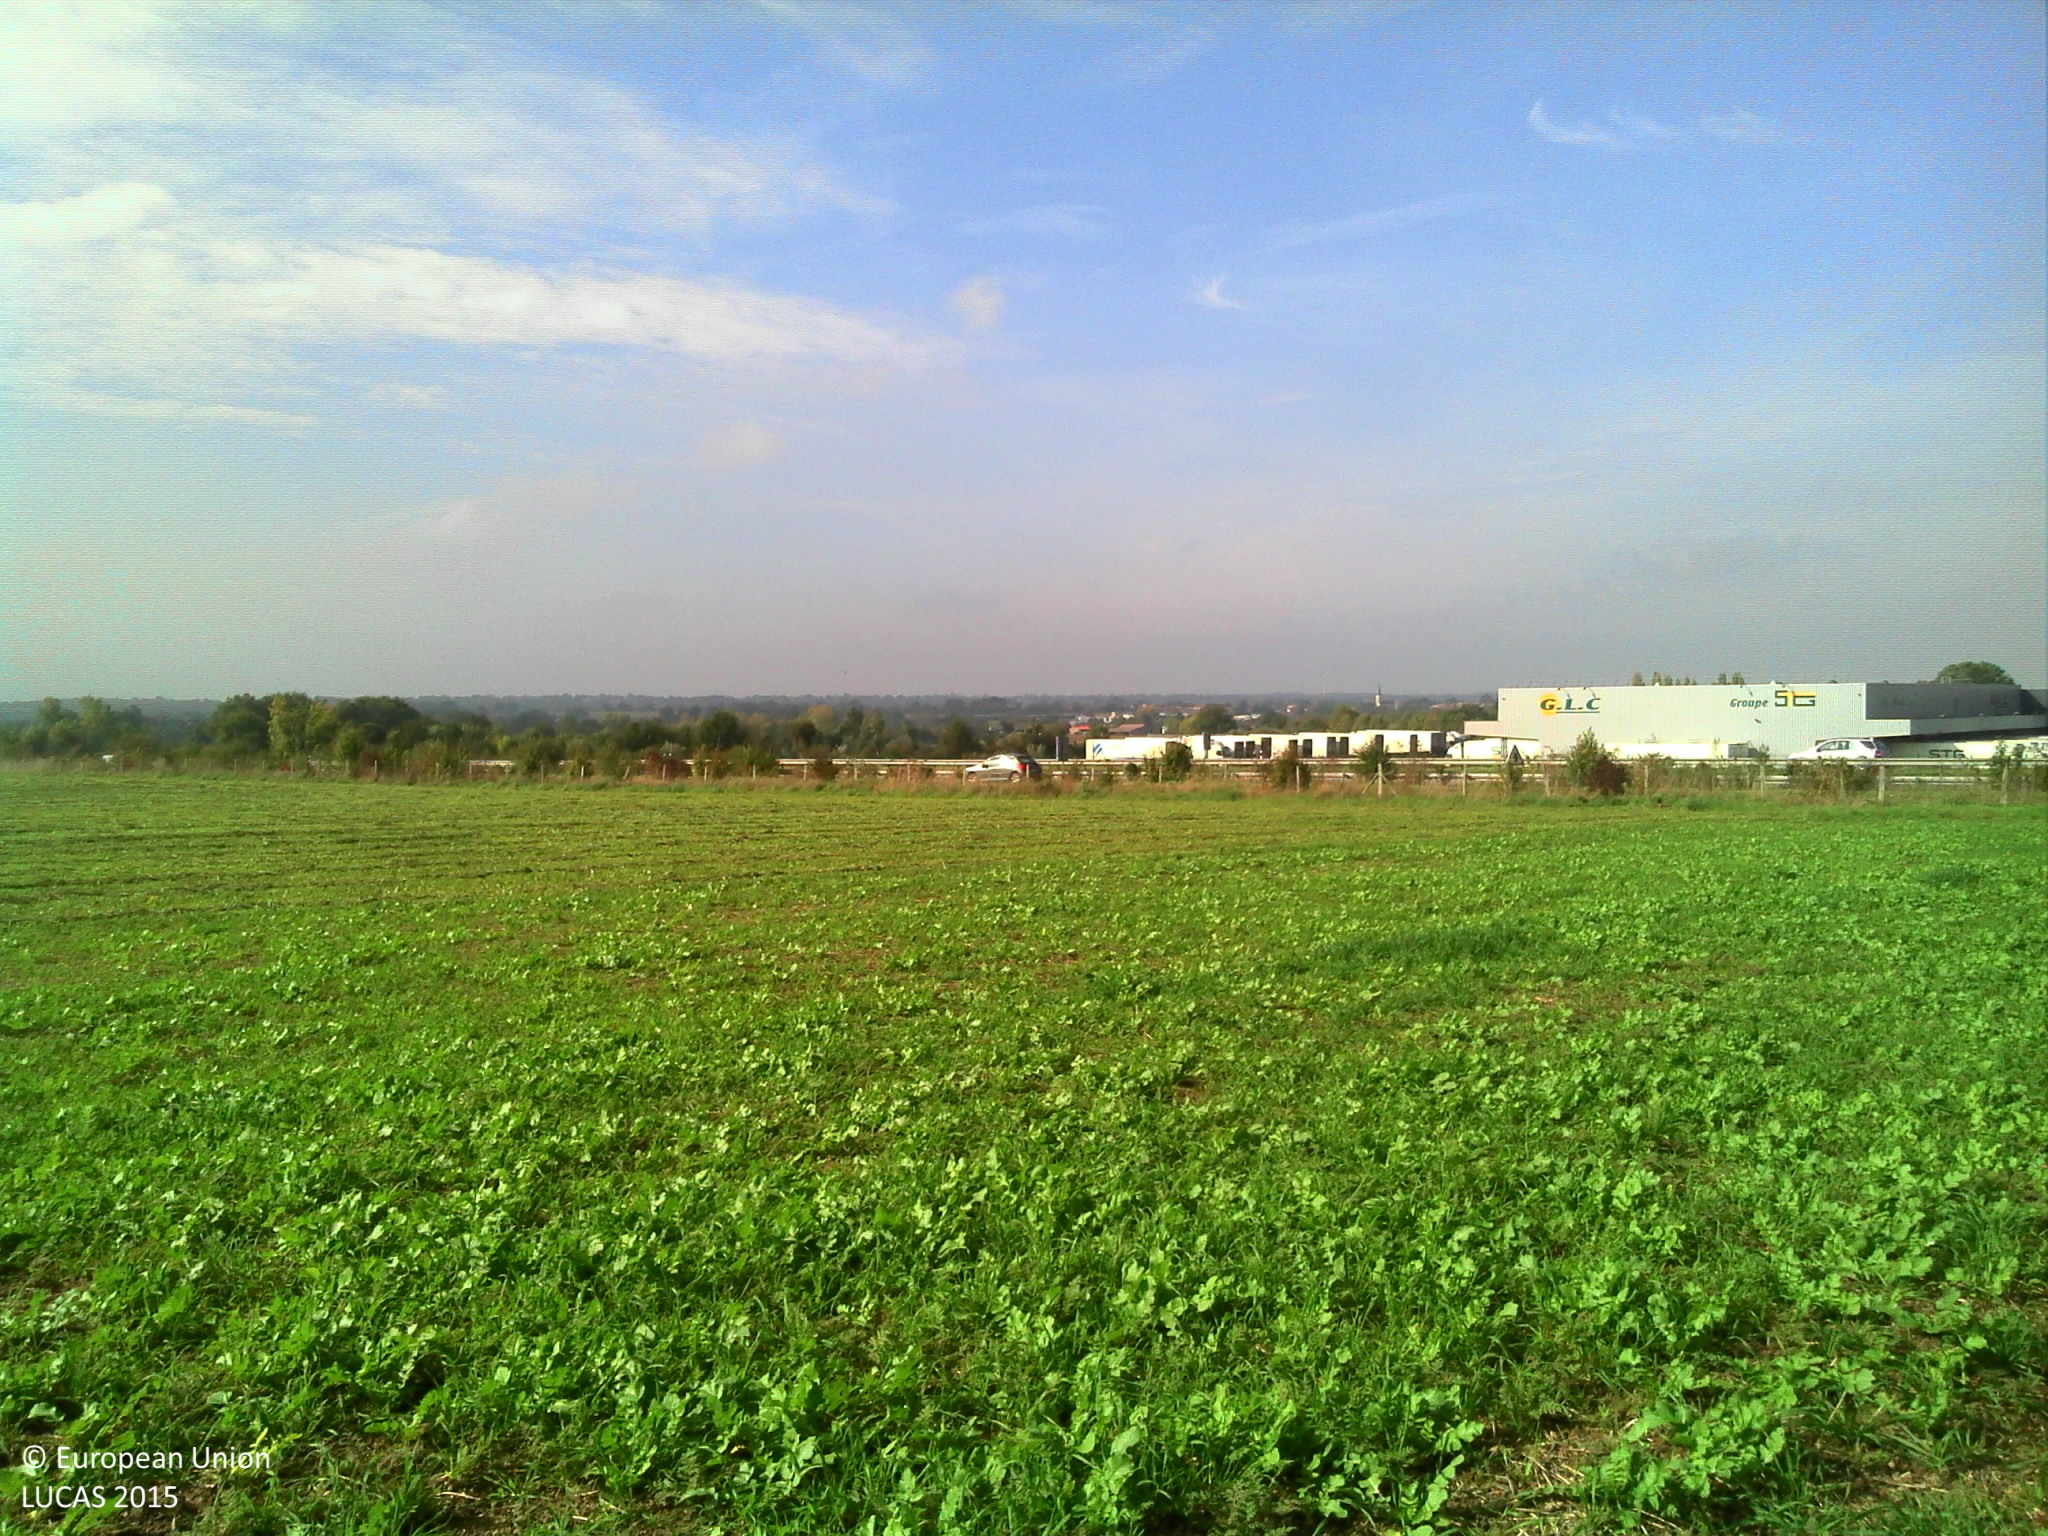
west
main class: Grassland
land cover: Spontaneously vegetated surfaces
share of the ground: > 75 %
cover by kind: herbaceous plants 95 %, unconsolidated bare surface 5 %
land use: Agriculture (excluding fallow land and kitchen gardens)
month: October
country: FR
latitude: 47.0262
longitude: -0.9148
